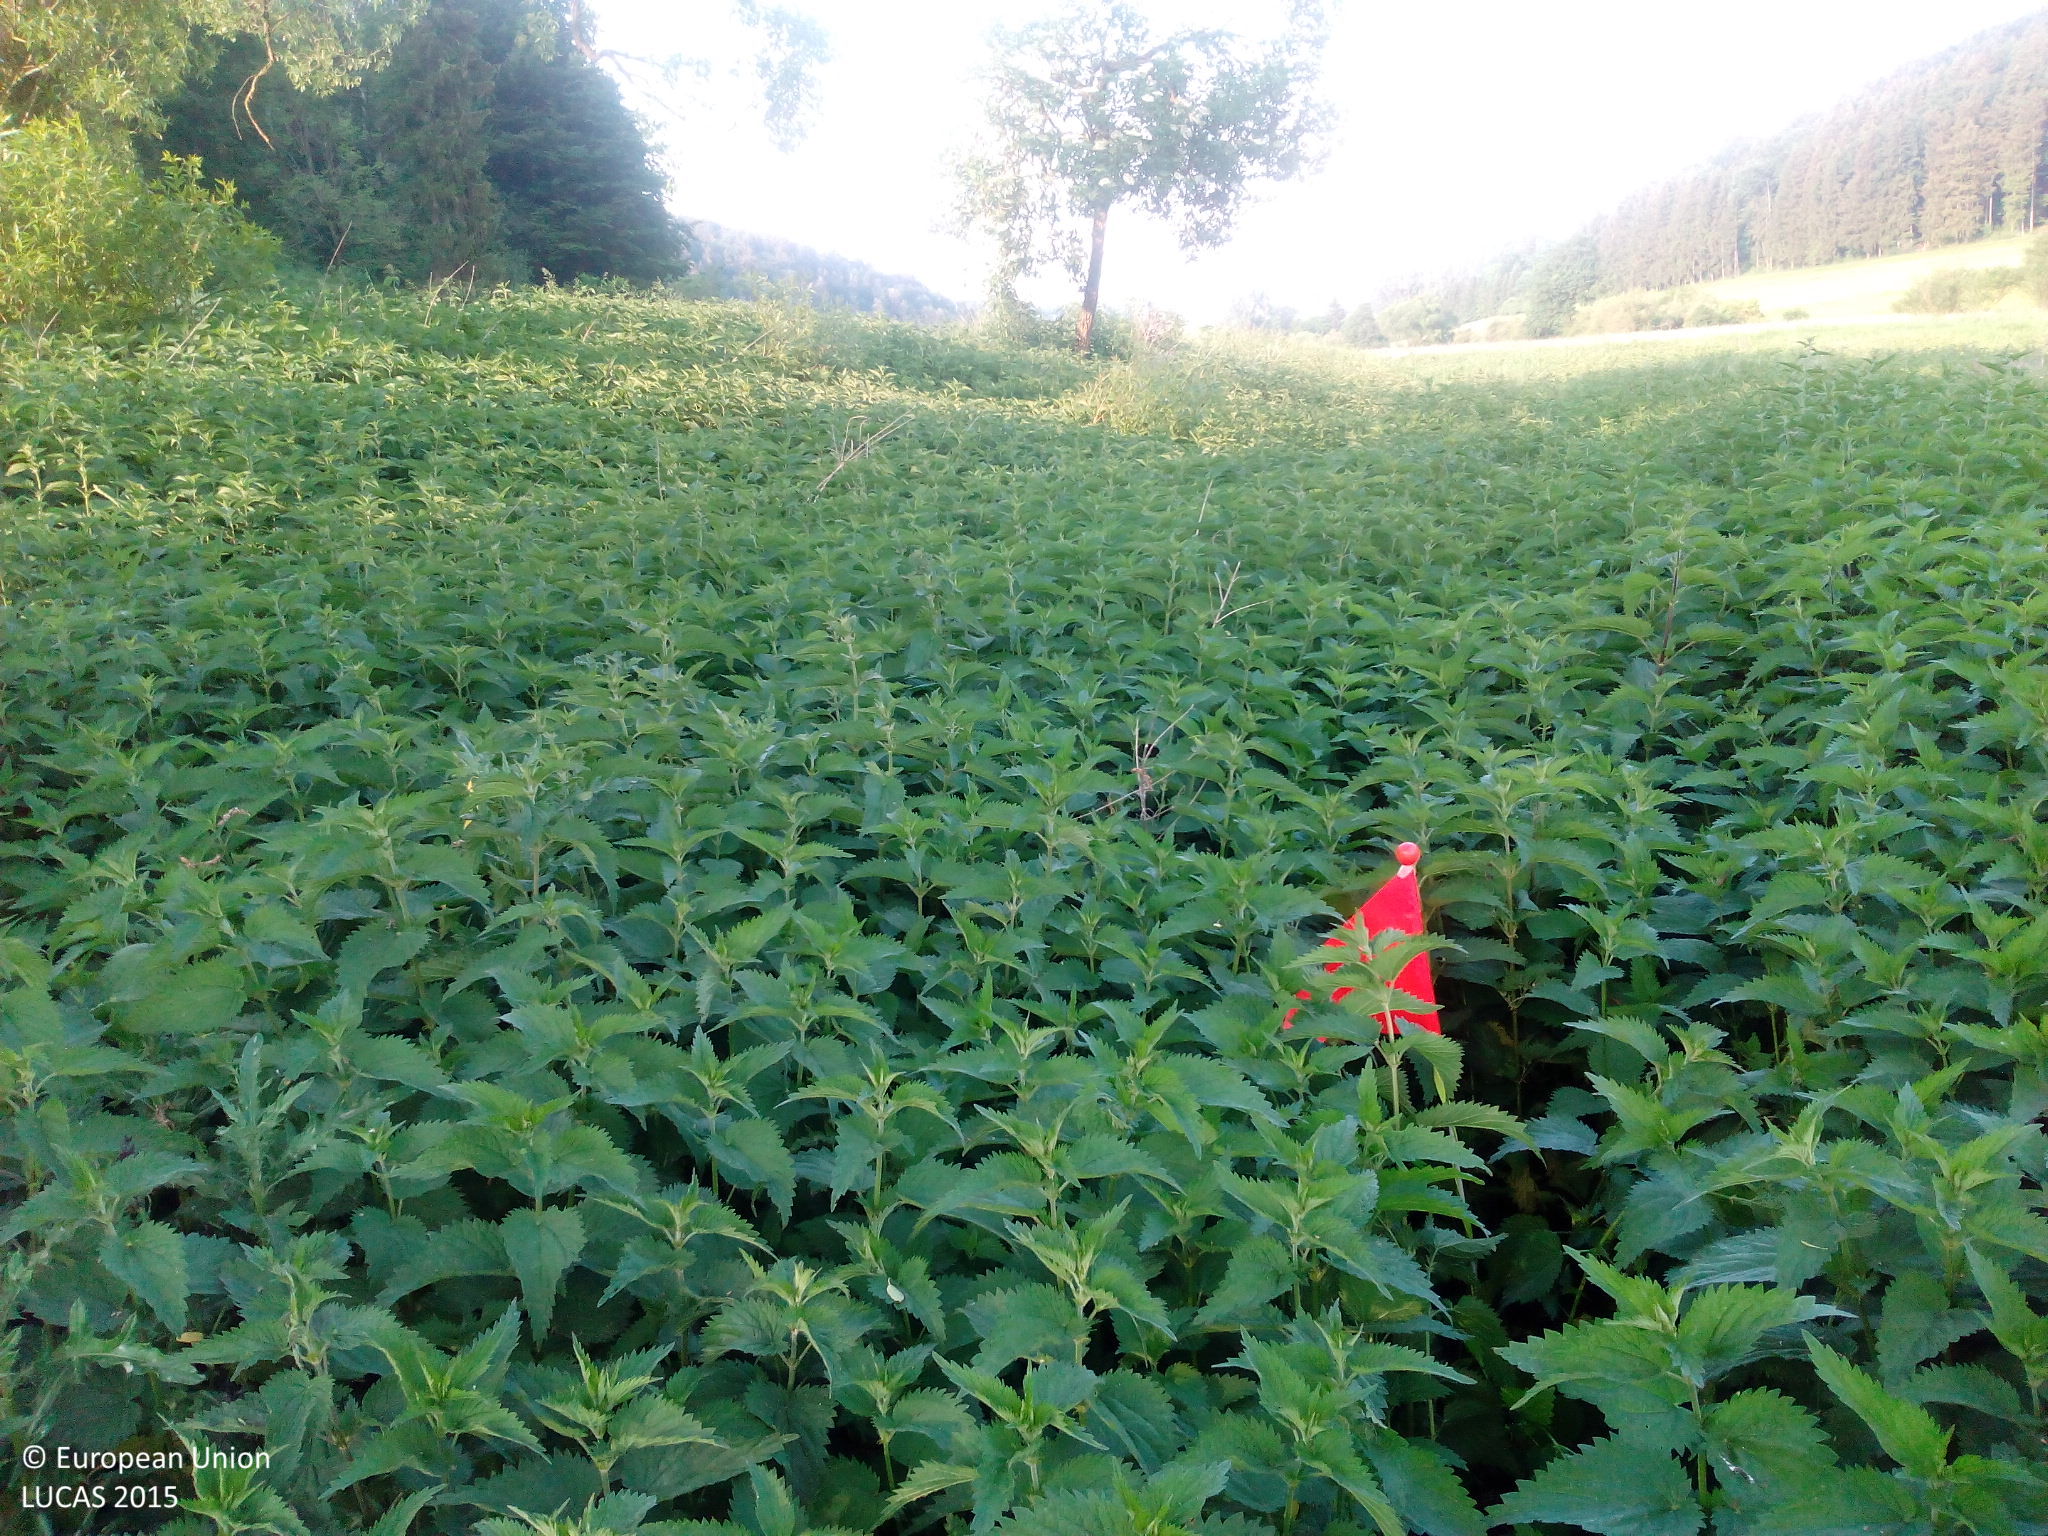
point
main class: Grassland
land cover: Spontaneously vegetated surfaces
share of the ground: > 75 %
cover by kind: herbaceous plants 100 %
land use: Semi-natural and natural areas not in use
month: June
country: DE
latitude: 48.9748
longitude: 10.9969
